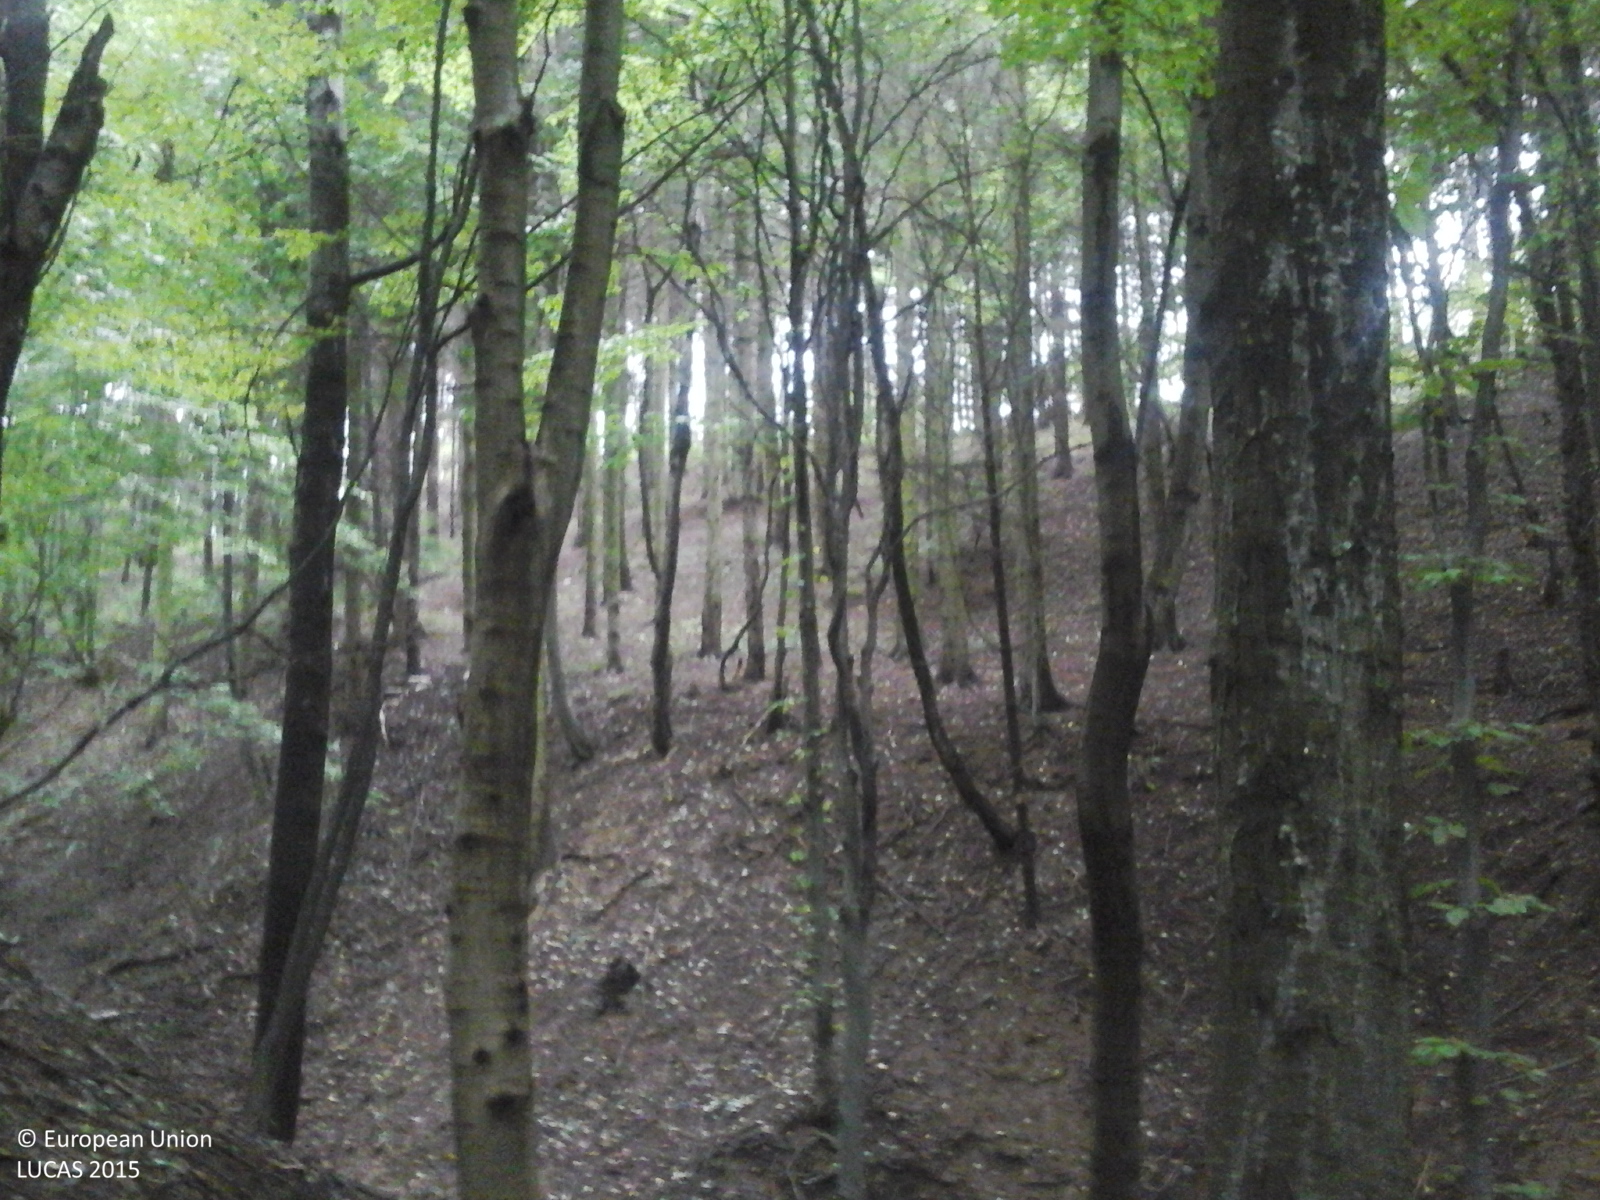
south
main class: Woodland
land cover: Other mixed woodland
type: beech forest
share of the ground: > 75 %
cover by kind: broadleaved forest trees 70 %, coniferous forest trees 30 %
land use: Forestry
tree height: > 5 m
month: September
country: RO
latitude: 45.8090
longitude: 23.7202
